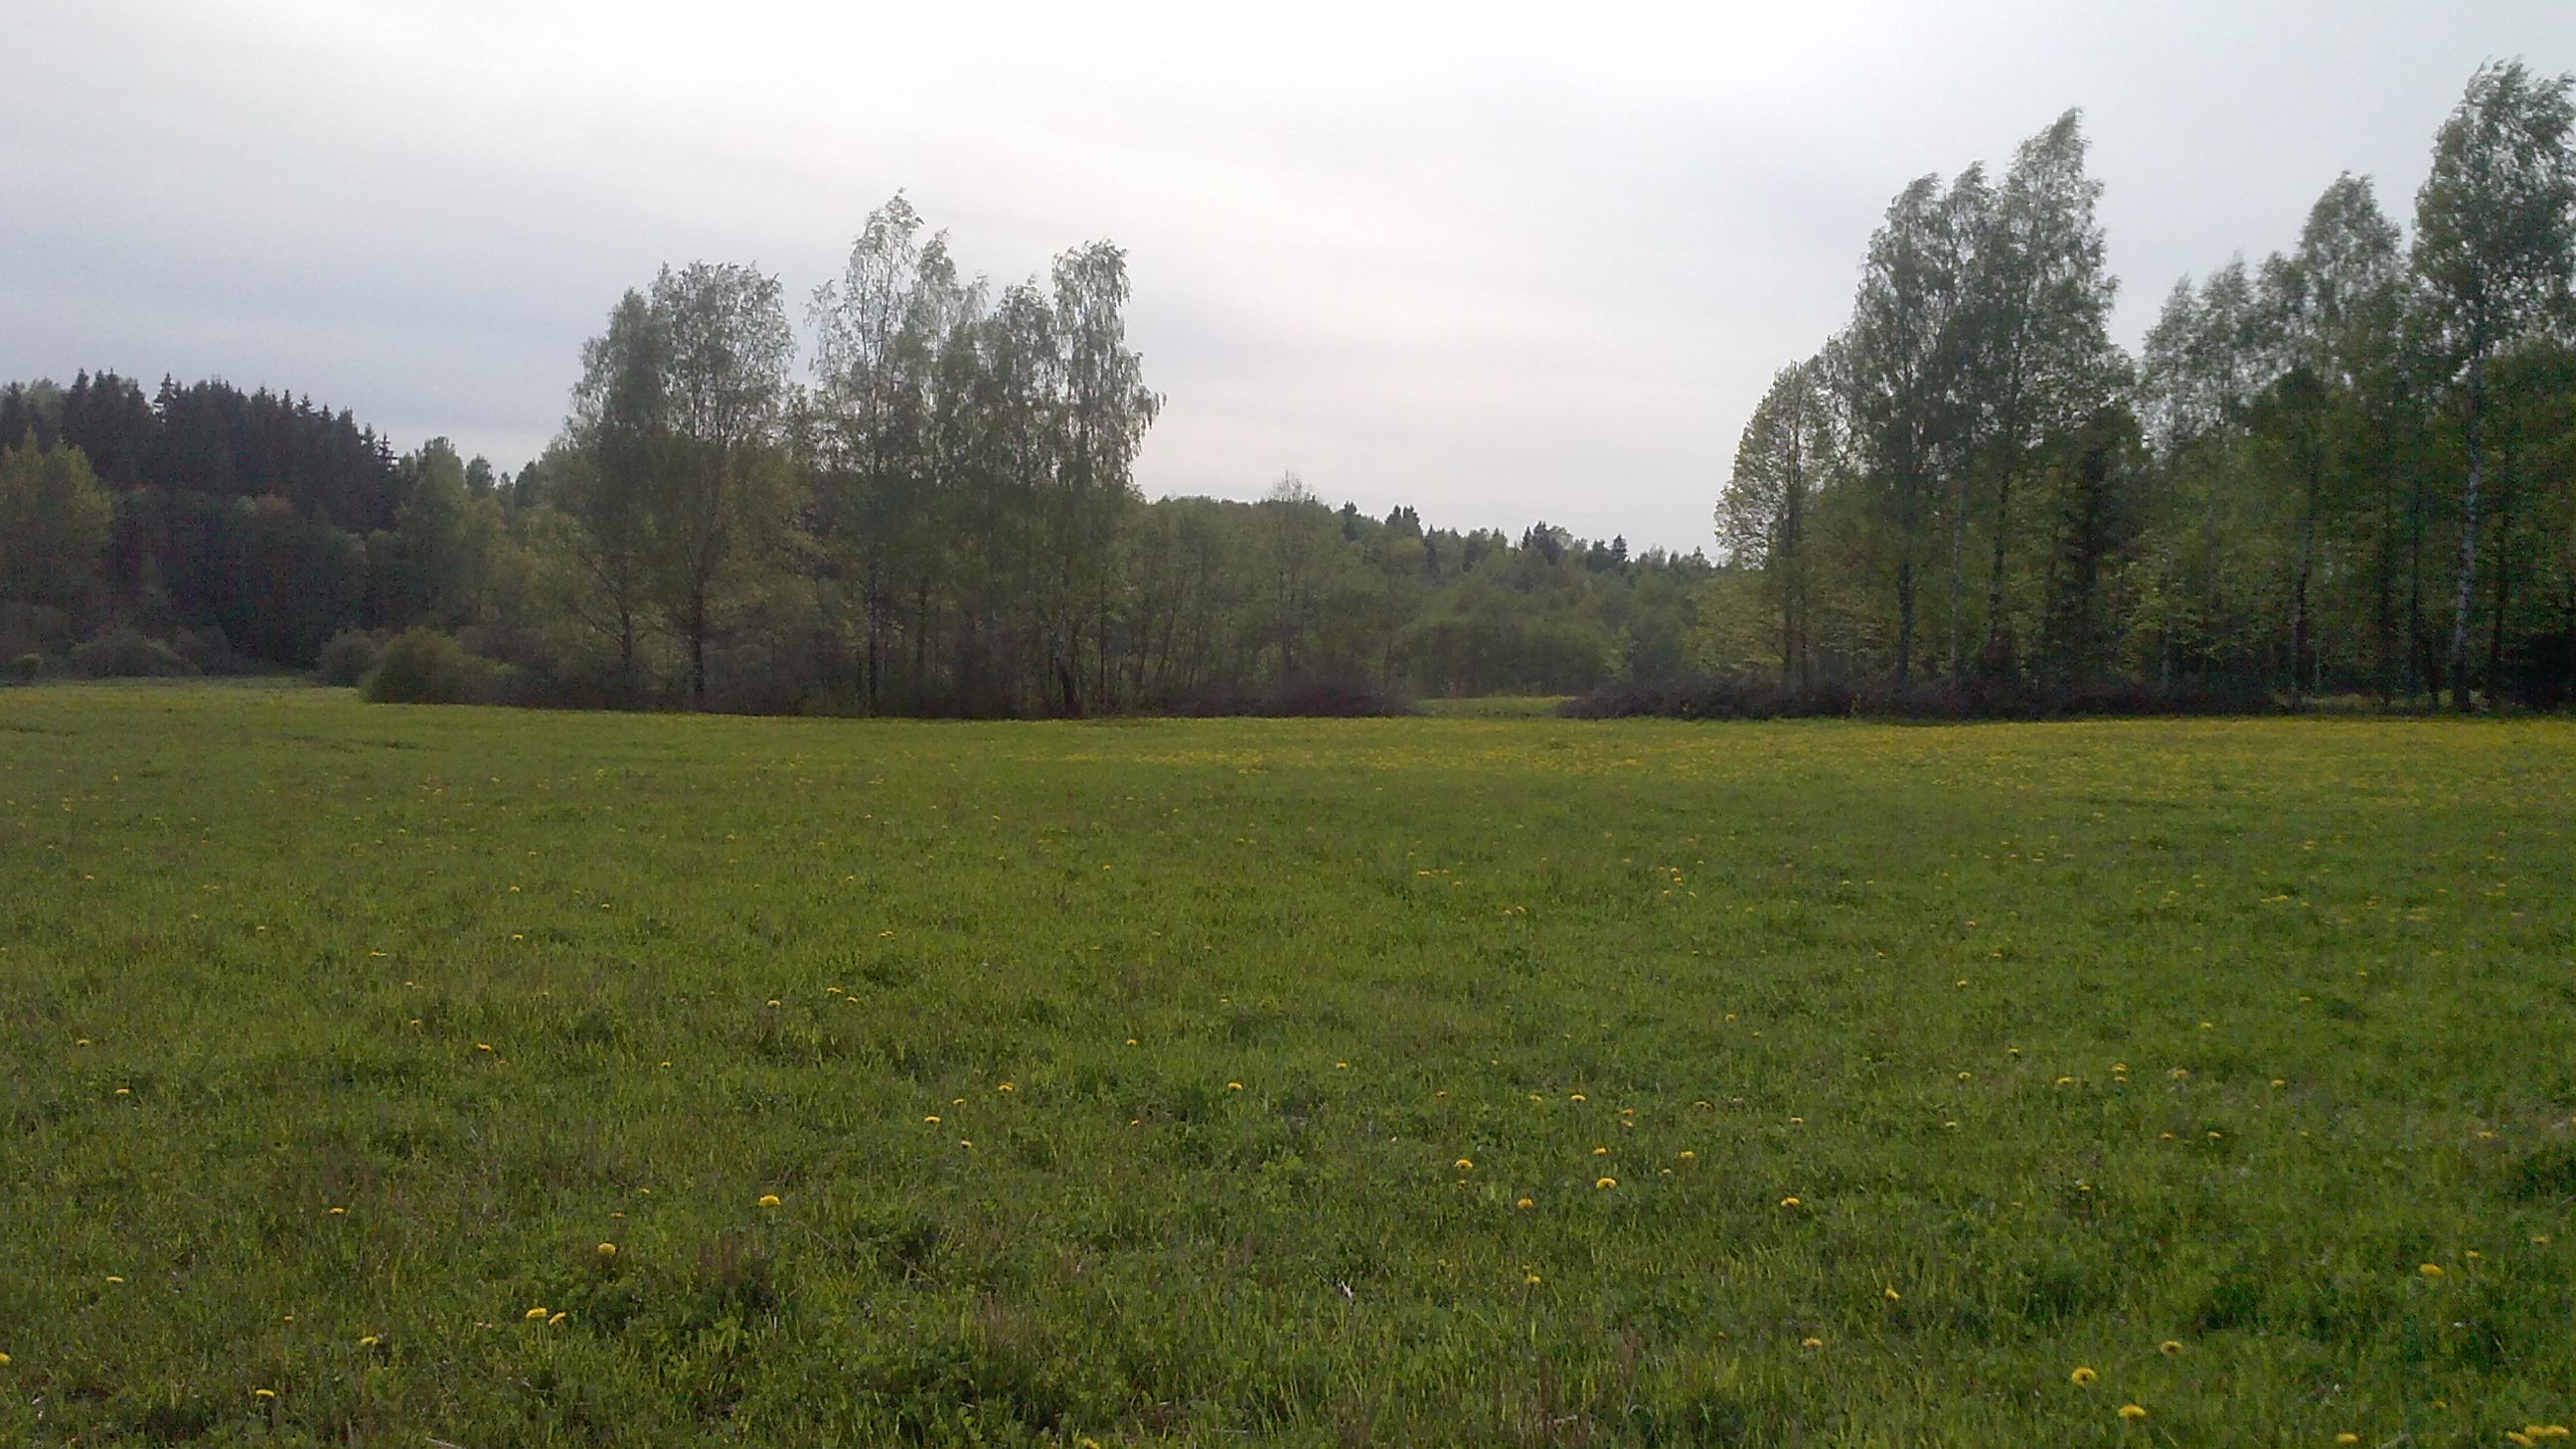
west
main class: Grassland
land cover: Grassland without tree/shrub cover
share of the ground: > 75 %
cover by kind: herbaceous plants 100 %
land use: Agriculture (excluding fallow land and kitchen gardens)
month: May
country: LV
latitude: 56.0103
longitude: 27.5868
